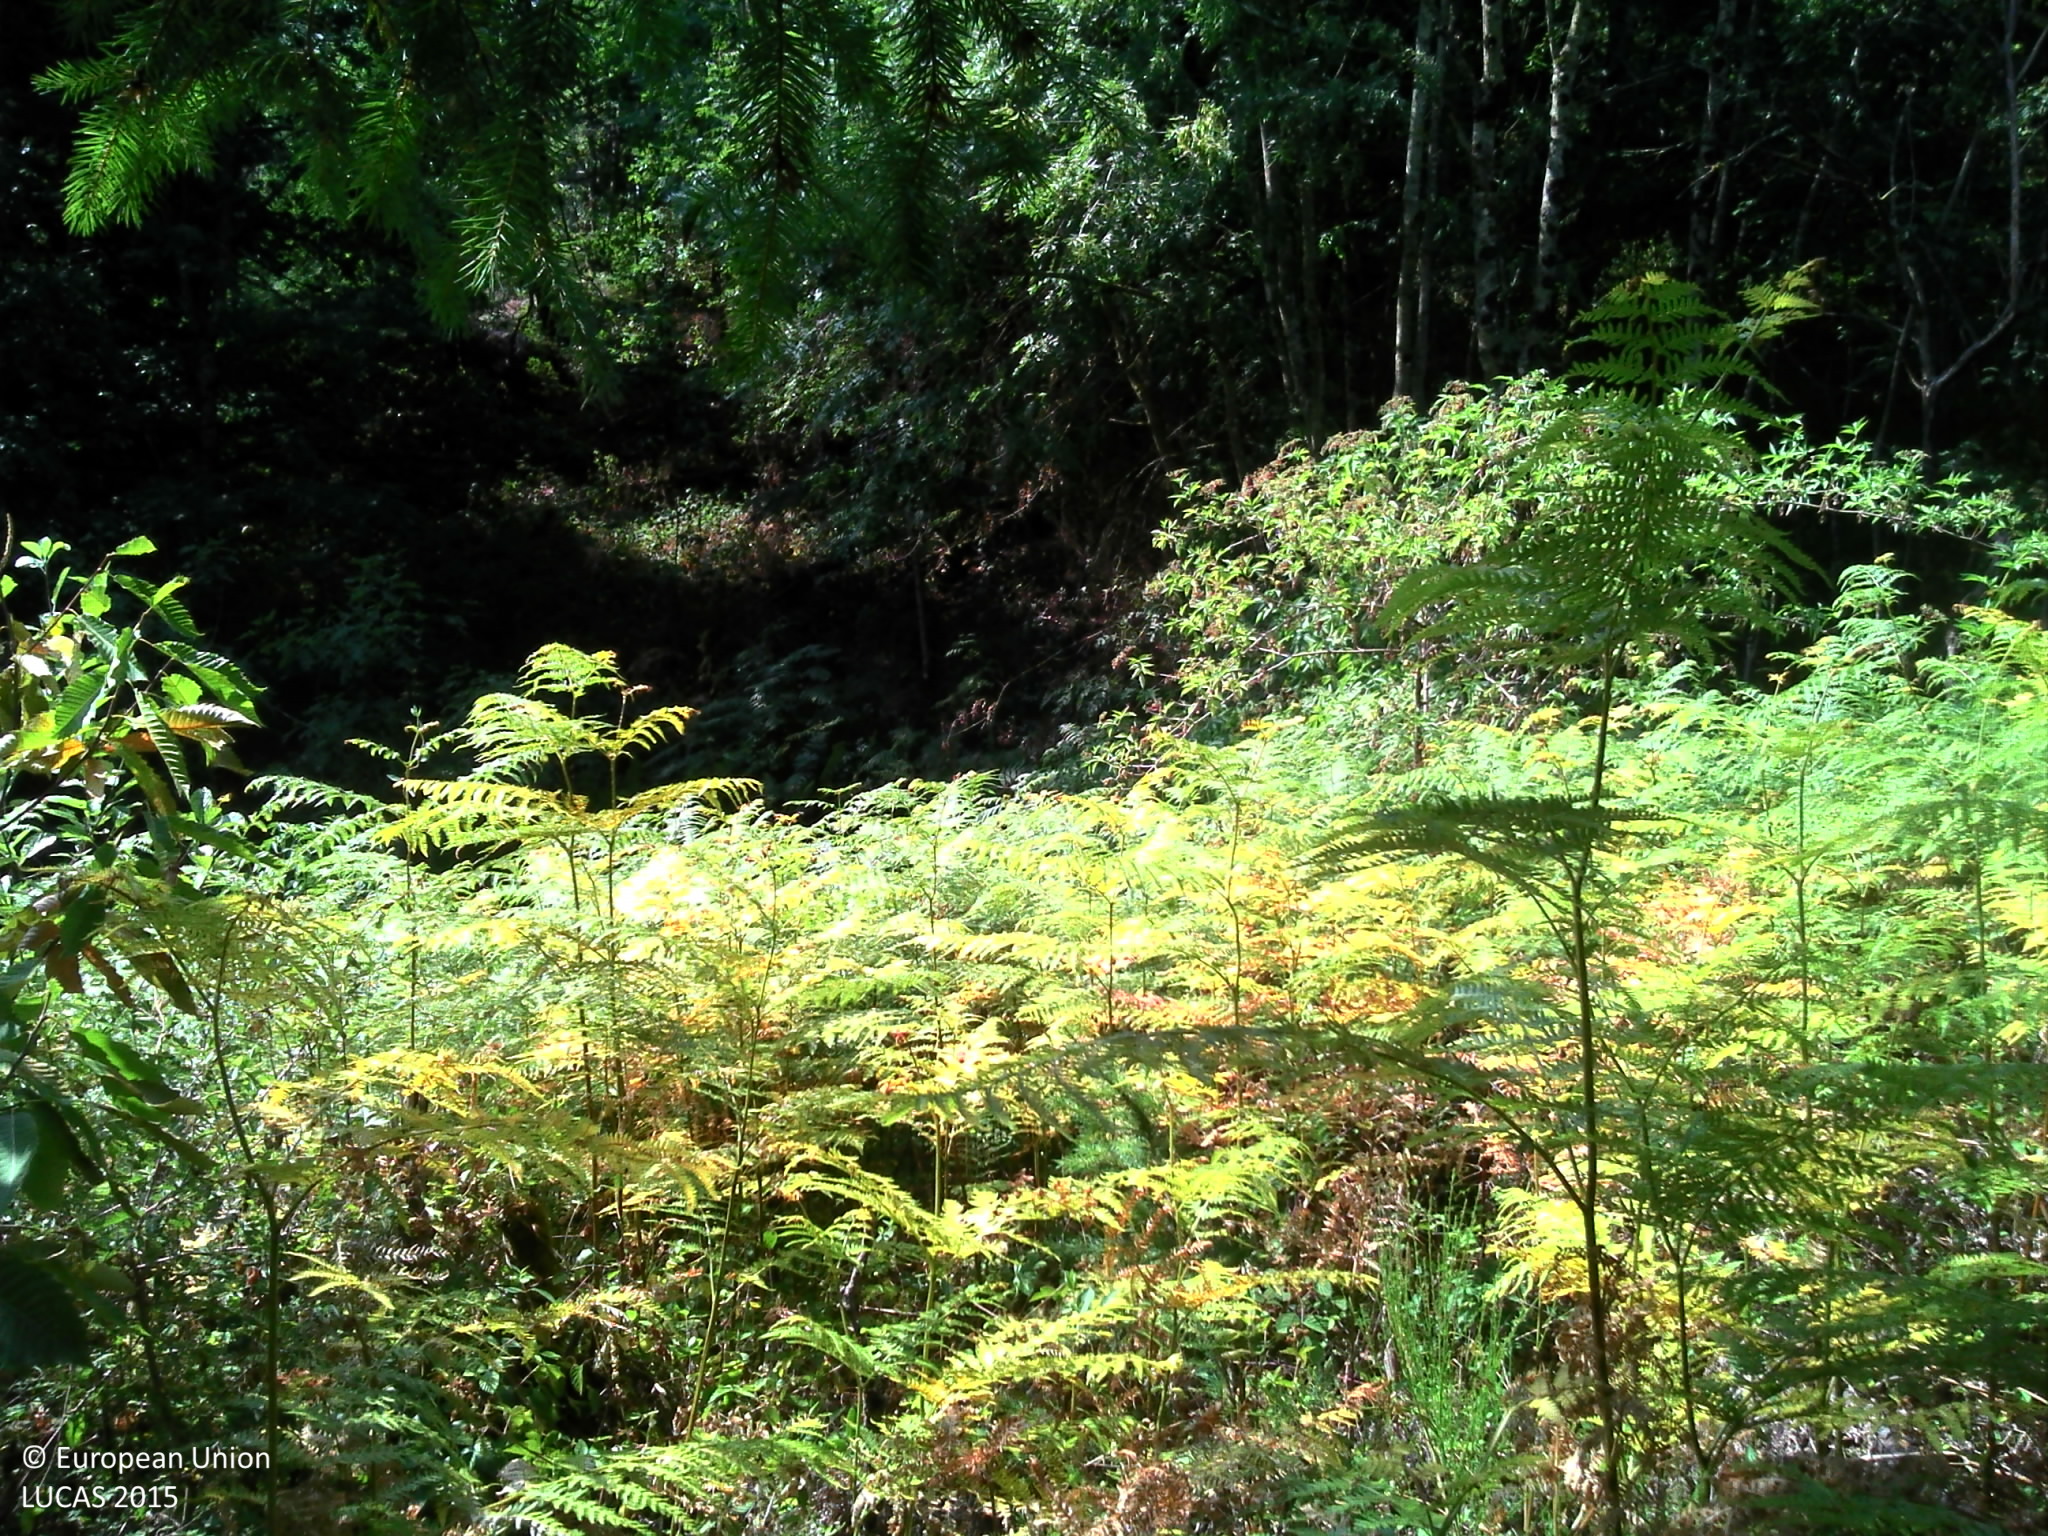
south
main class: Grassland
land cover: Spontaneously vegetated surfaces
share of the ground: > 75 %
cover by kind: herbaceous plants 95 %, shrubs 5 %
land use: Forestry
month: July
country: FR
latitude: 45.9373
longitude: 4.4694
